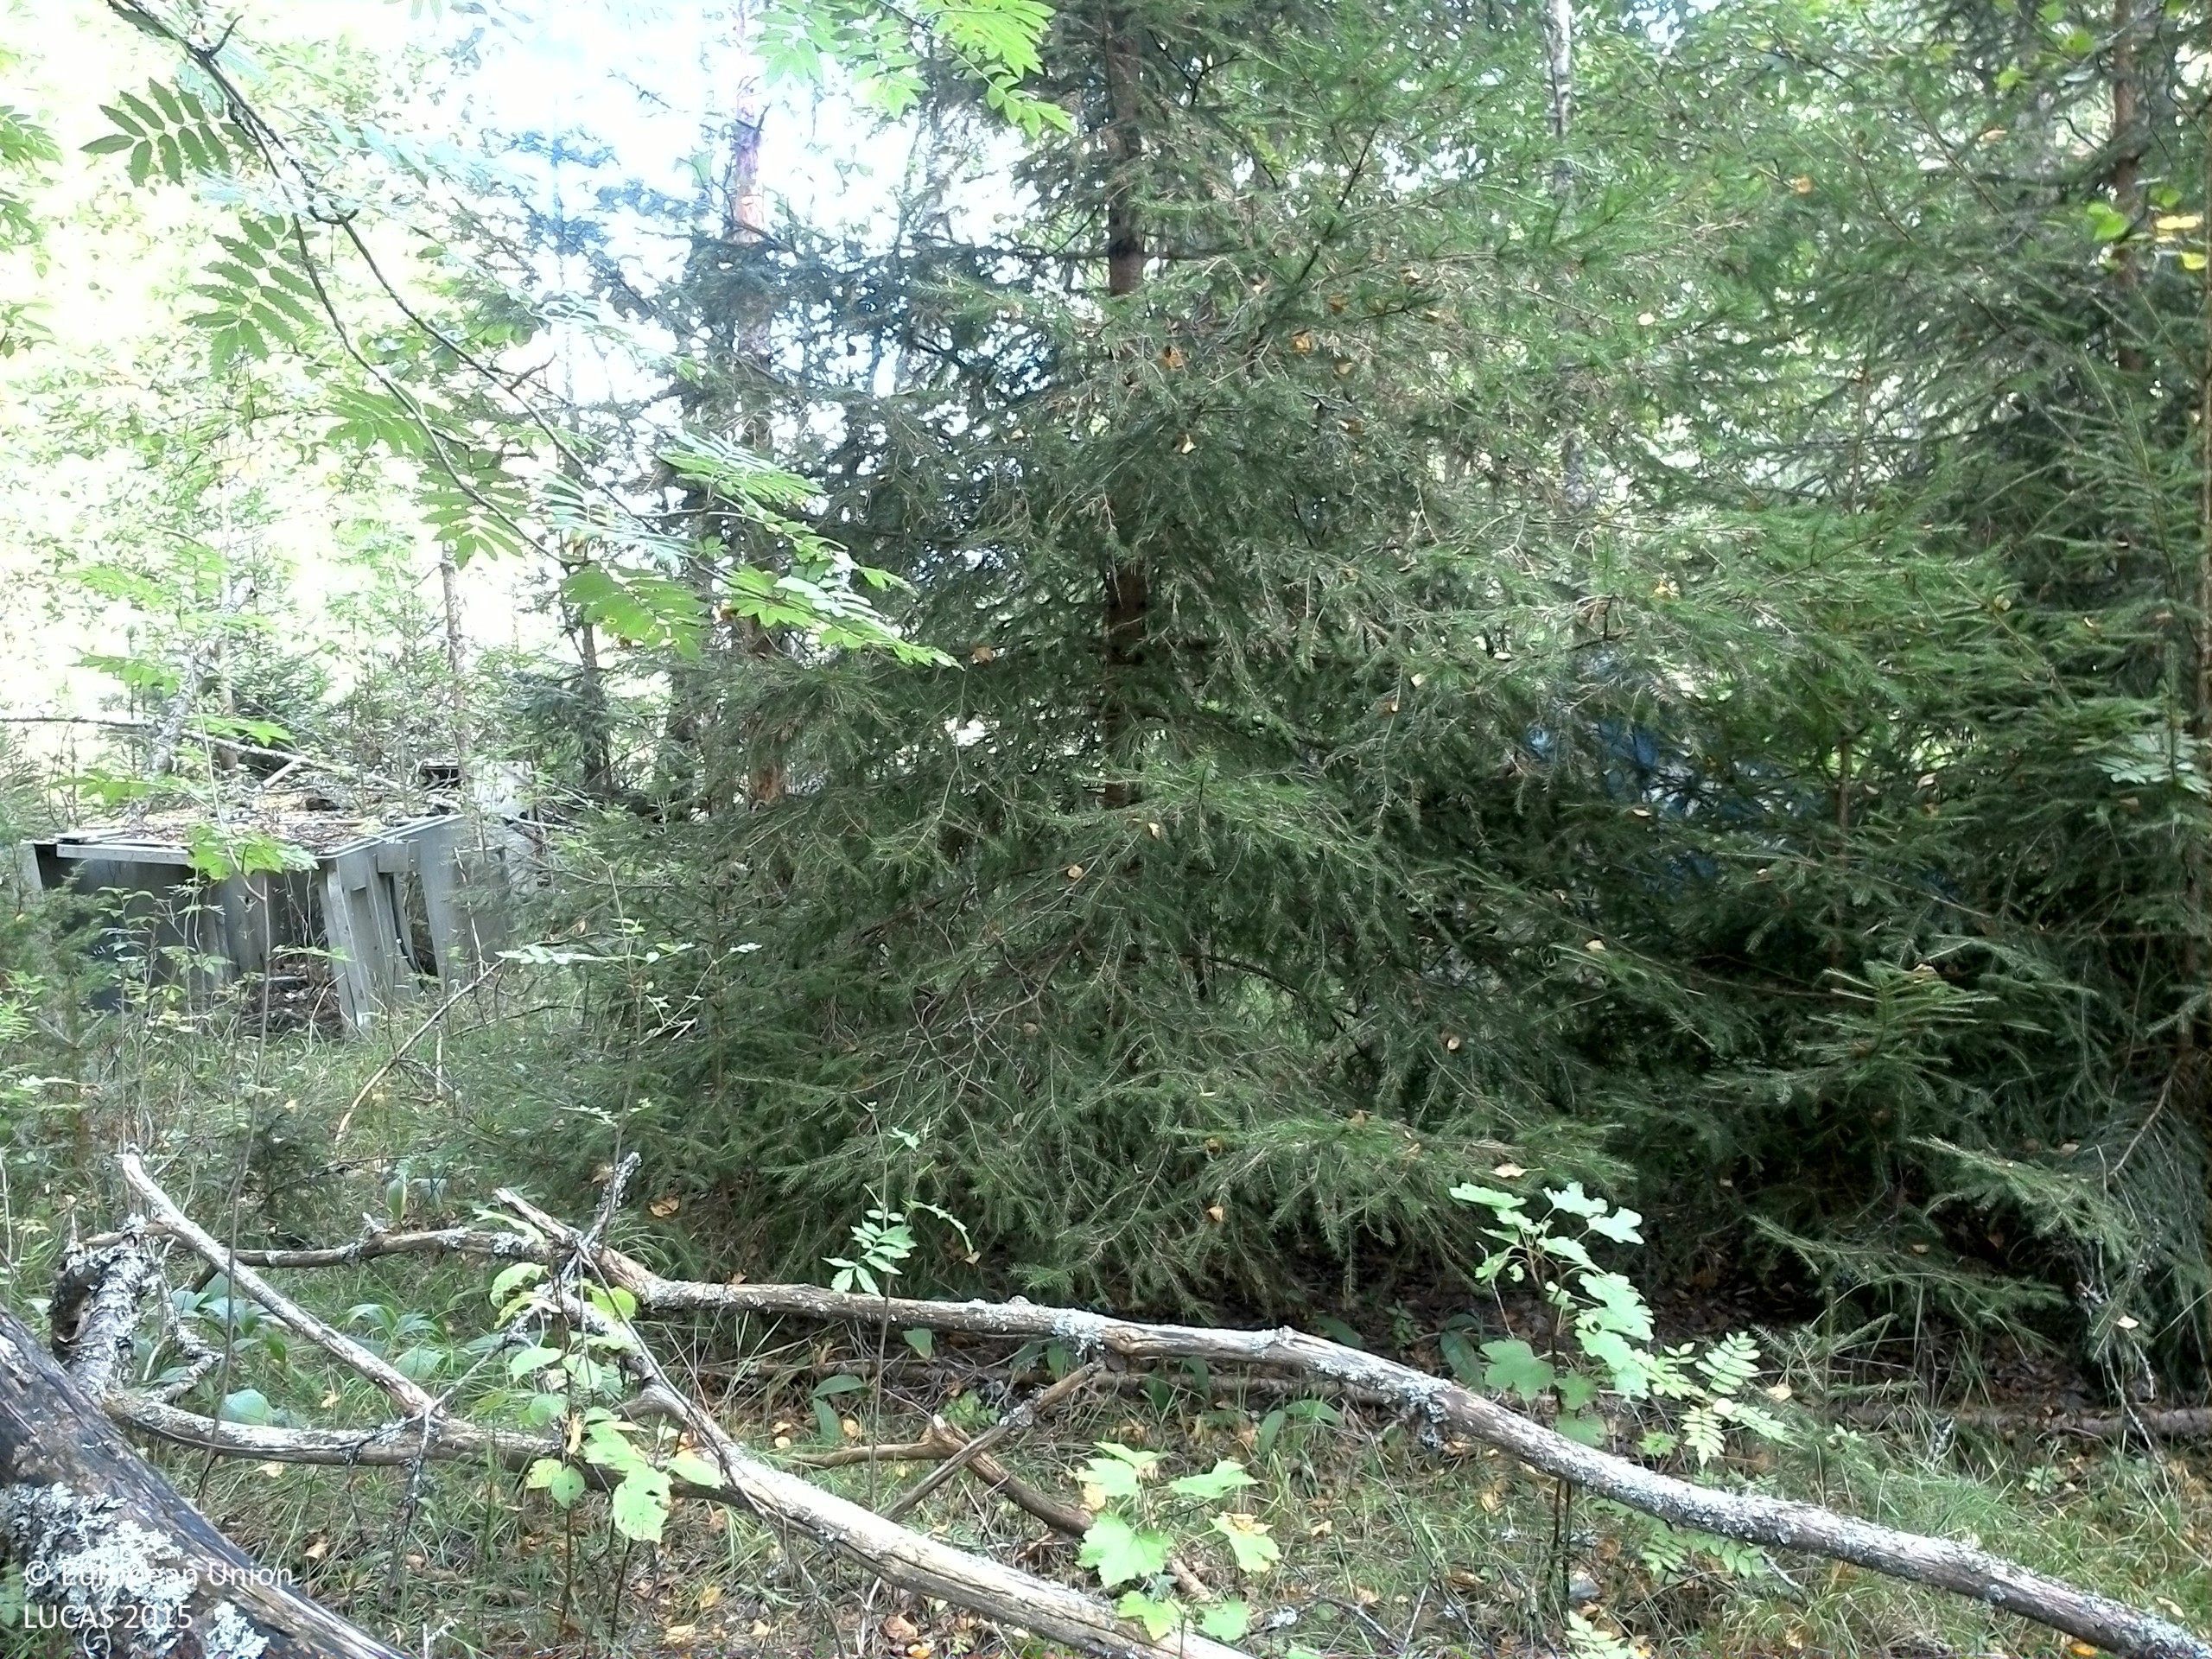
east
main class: Woodland
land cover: Pine dominated mixed woodland
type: boreal forest
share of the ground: 50 - 75 %
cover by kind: coniferous forest trees 50 %, broadleaved forest trees 20 %, shrubs 20 %, lichens and mosses 10 %
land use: Forestry
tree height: > 5 m
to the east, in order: Pine dominated mixed woodland; Grassland without tree/shrub cover; Electric lines; Grassland without tree/shrub cover; Ditches and canals; Paved roads, cycling and walking lanes; Grass margins; Ditches and canals; Grass margins; Oats; Electric lines; Oats; Grass margins; Pine dominated mixed woodland; Spruce dominated mixed woodland
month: September
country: SE
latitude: 59.7948
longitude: 13.5018
